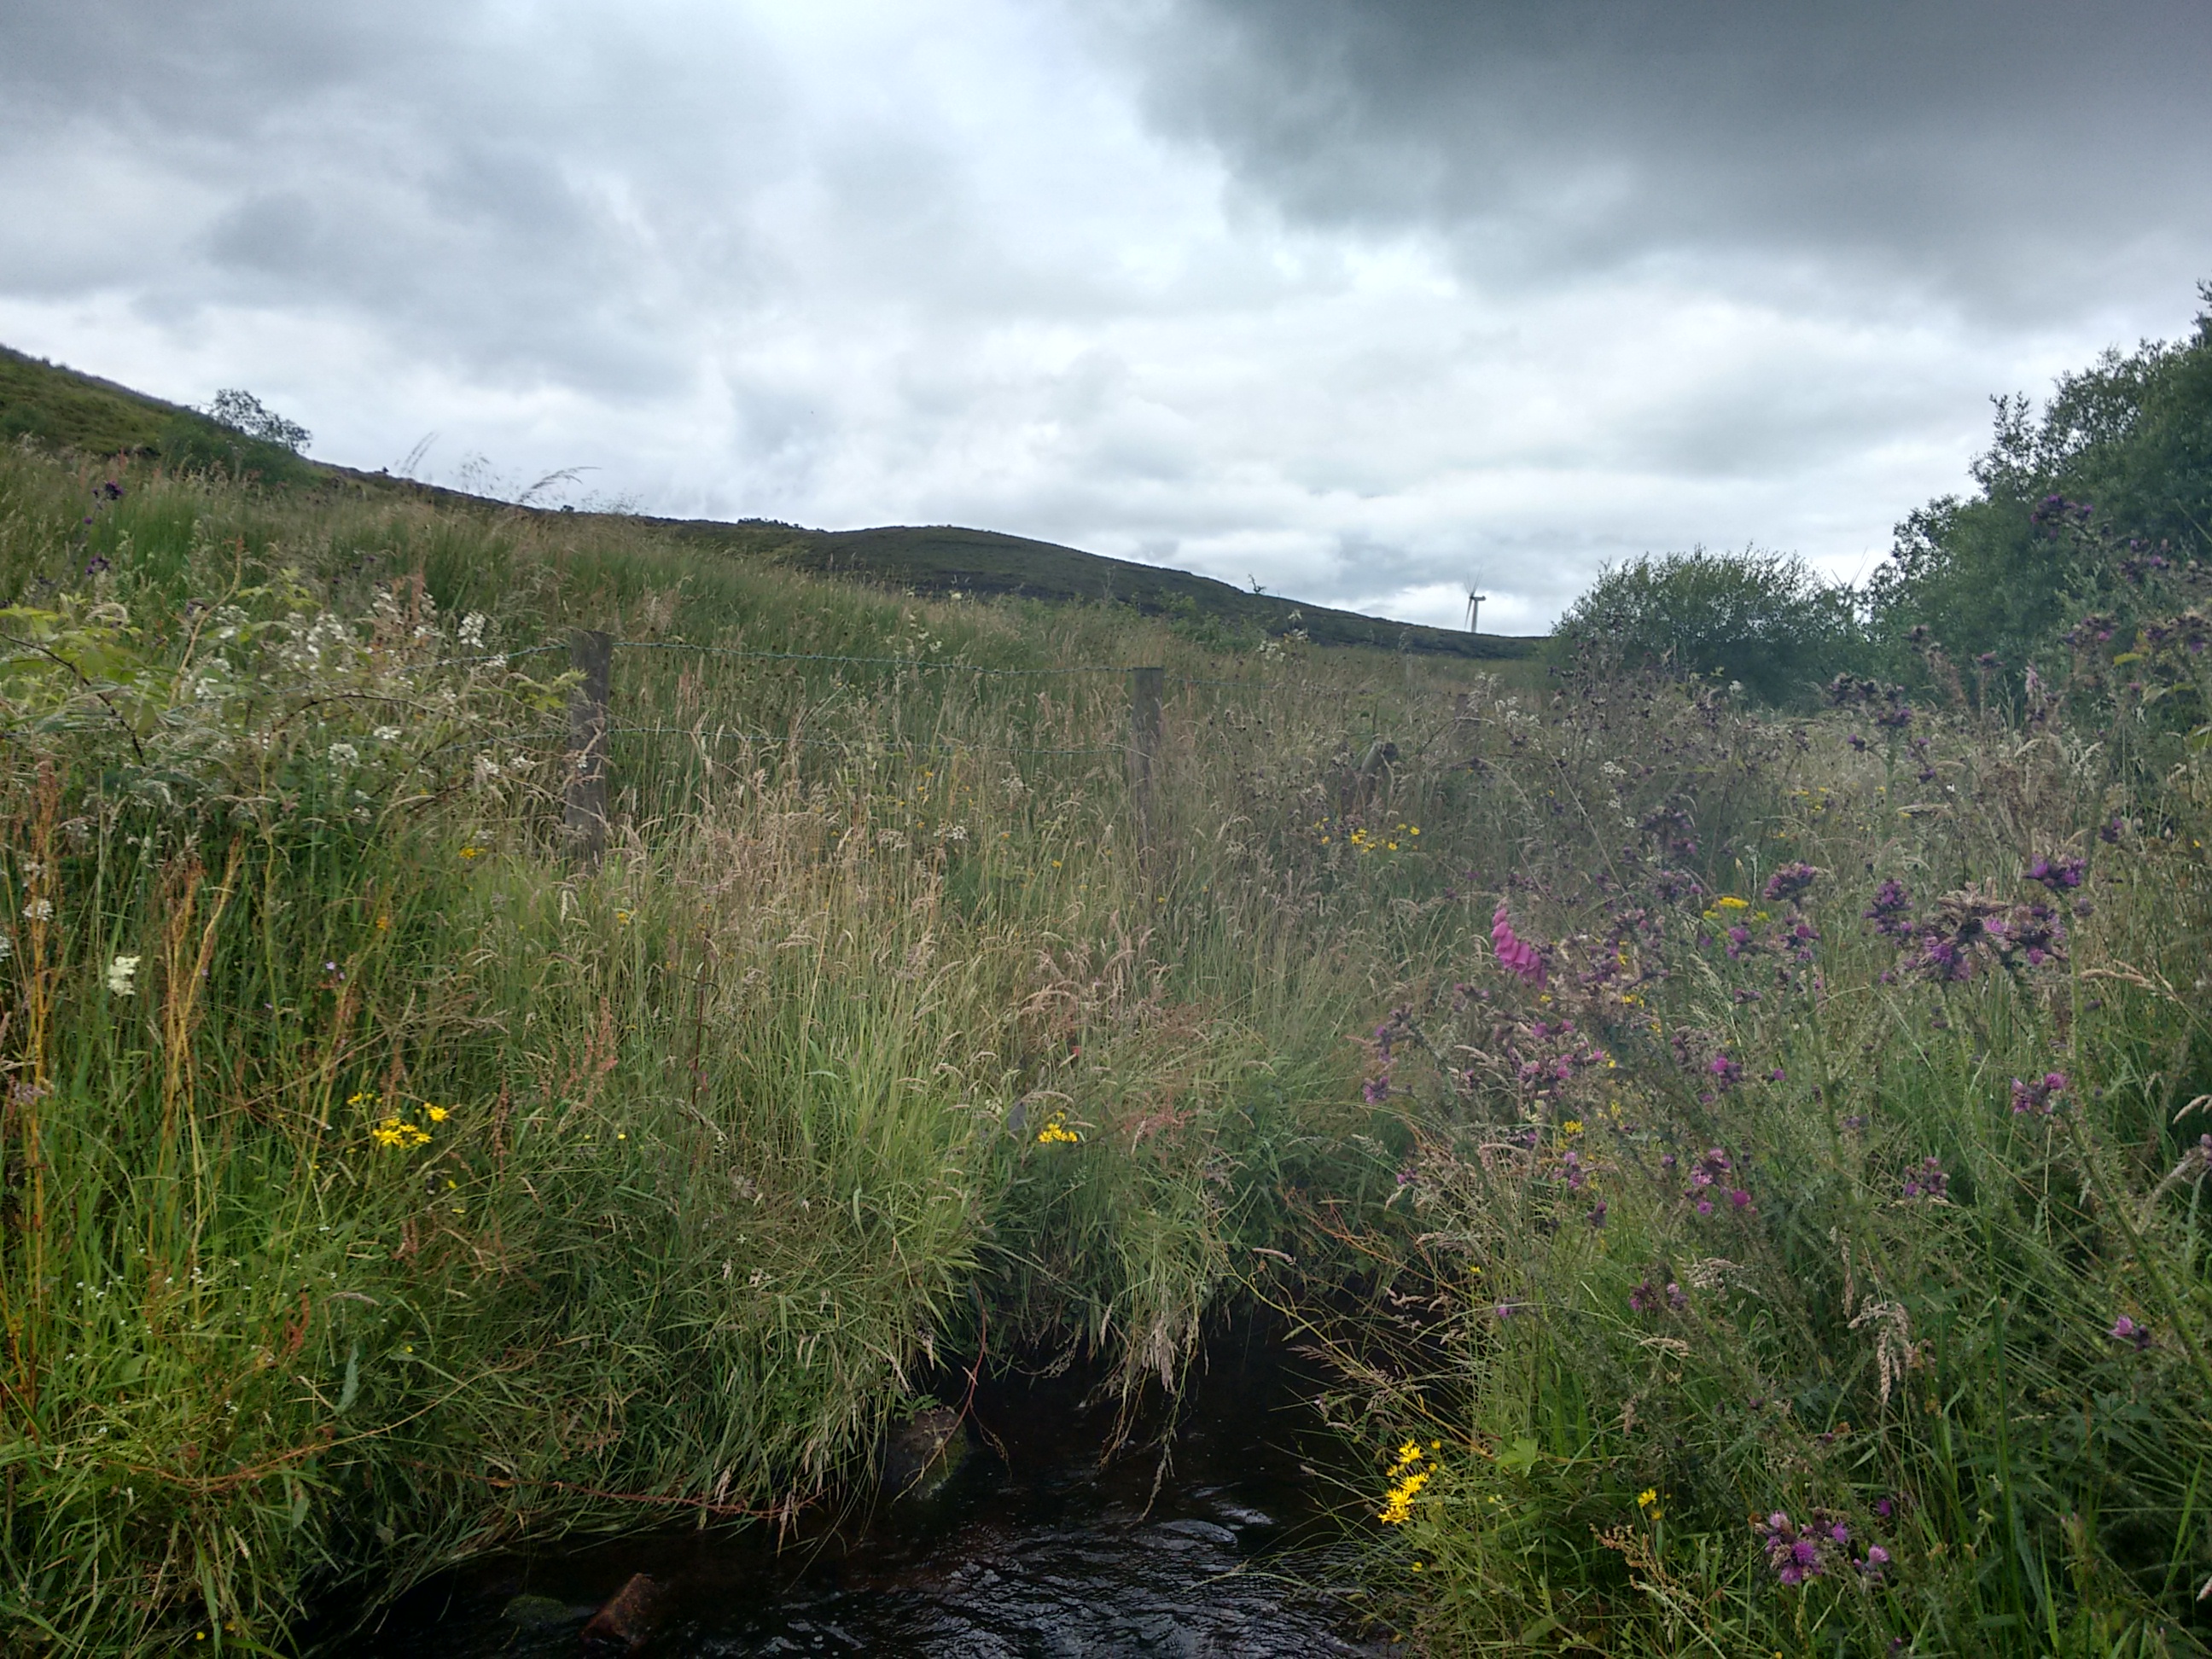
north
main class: Grassland
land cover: Grassland without tree/shrub cover
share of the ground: > 75 %
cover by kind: herbaceous plants 100 %
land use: Agriculture (excluding fallow land and kitchen gardens)
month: July
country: GB
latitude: 54.4909
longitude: -7.1094
